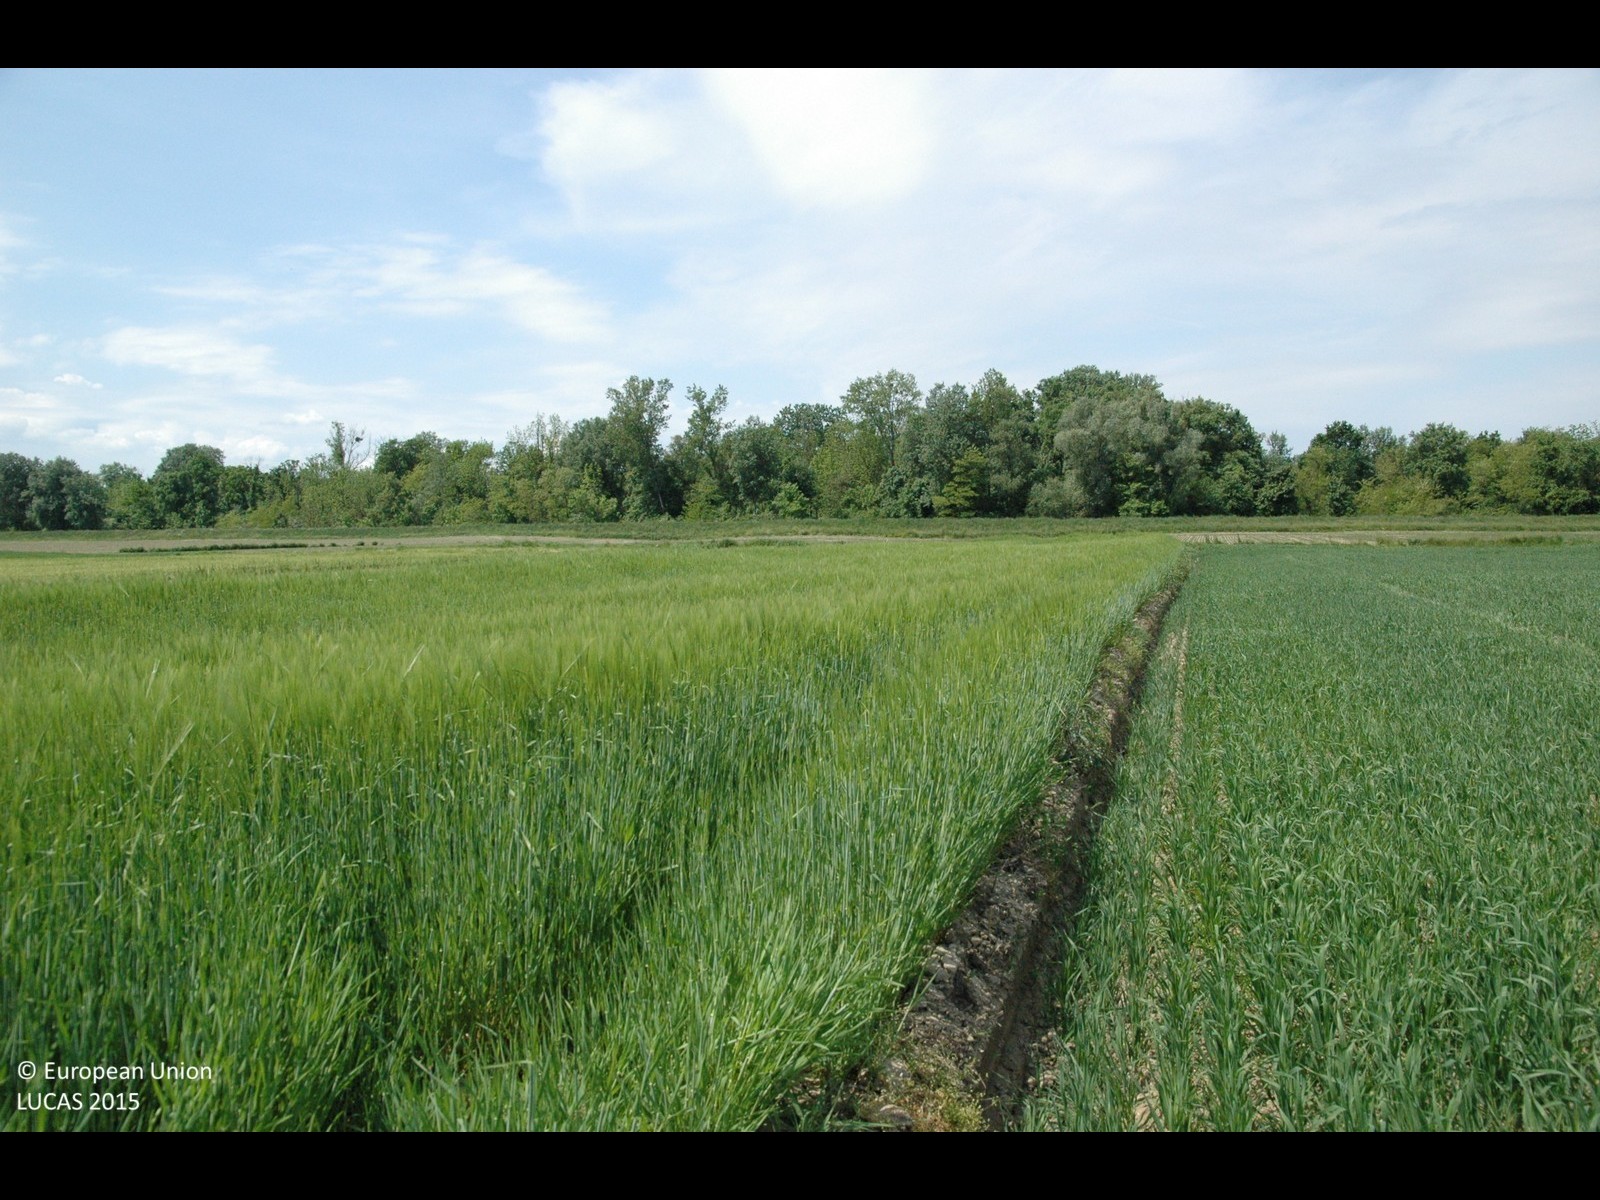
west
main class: Cropland
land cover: Common wheat
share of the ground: > 75 %
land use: Agriculture (excluding fallow land and kitchen gardens)
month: May
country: HR
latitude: 46.3429
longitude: 16.3538
